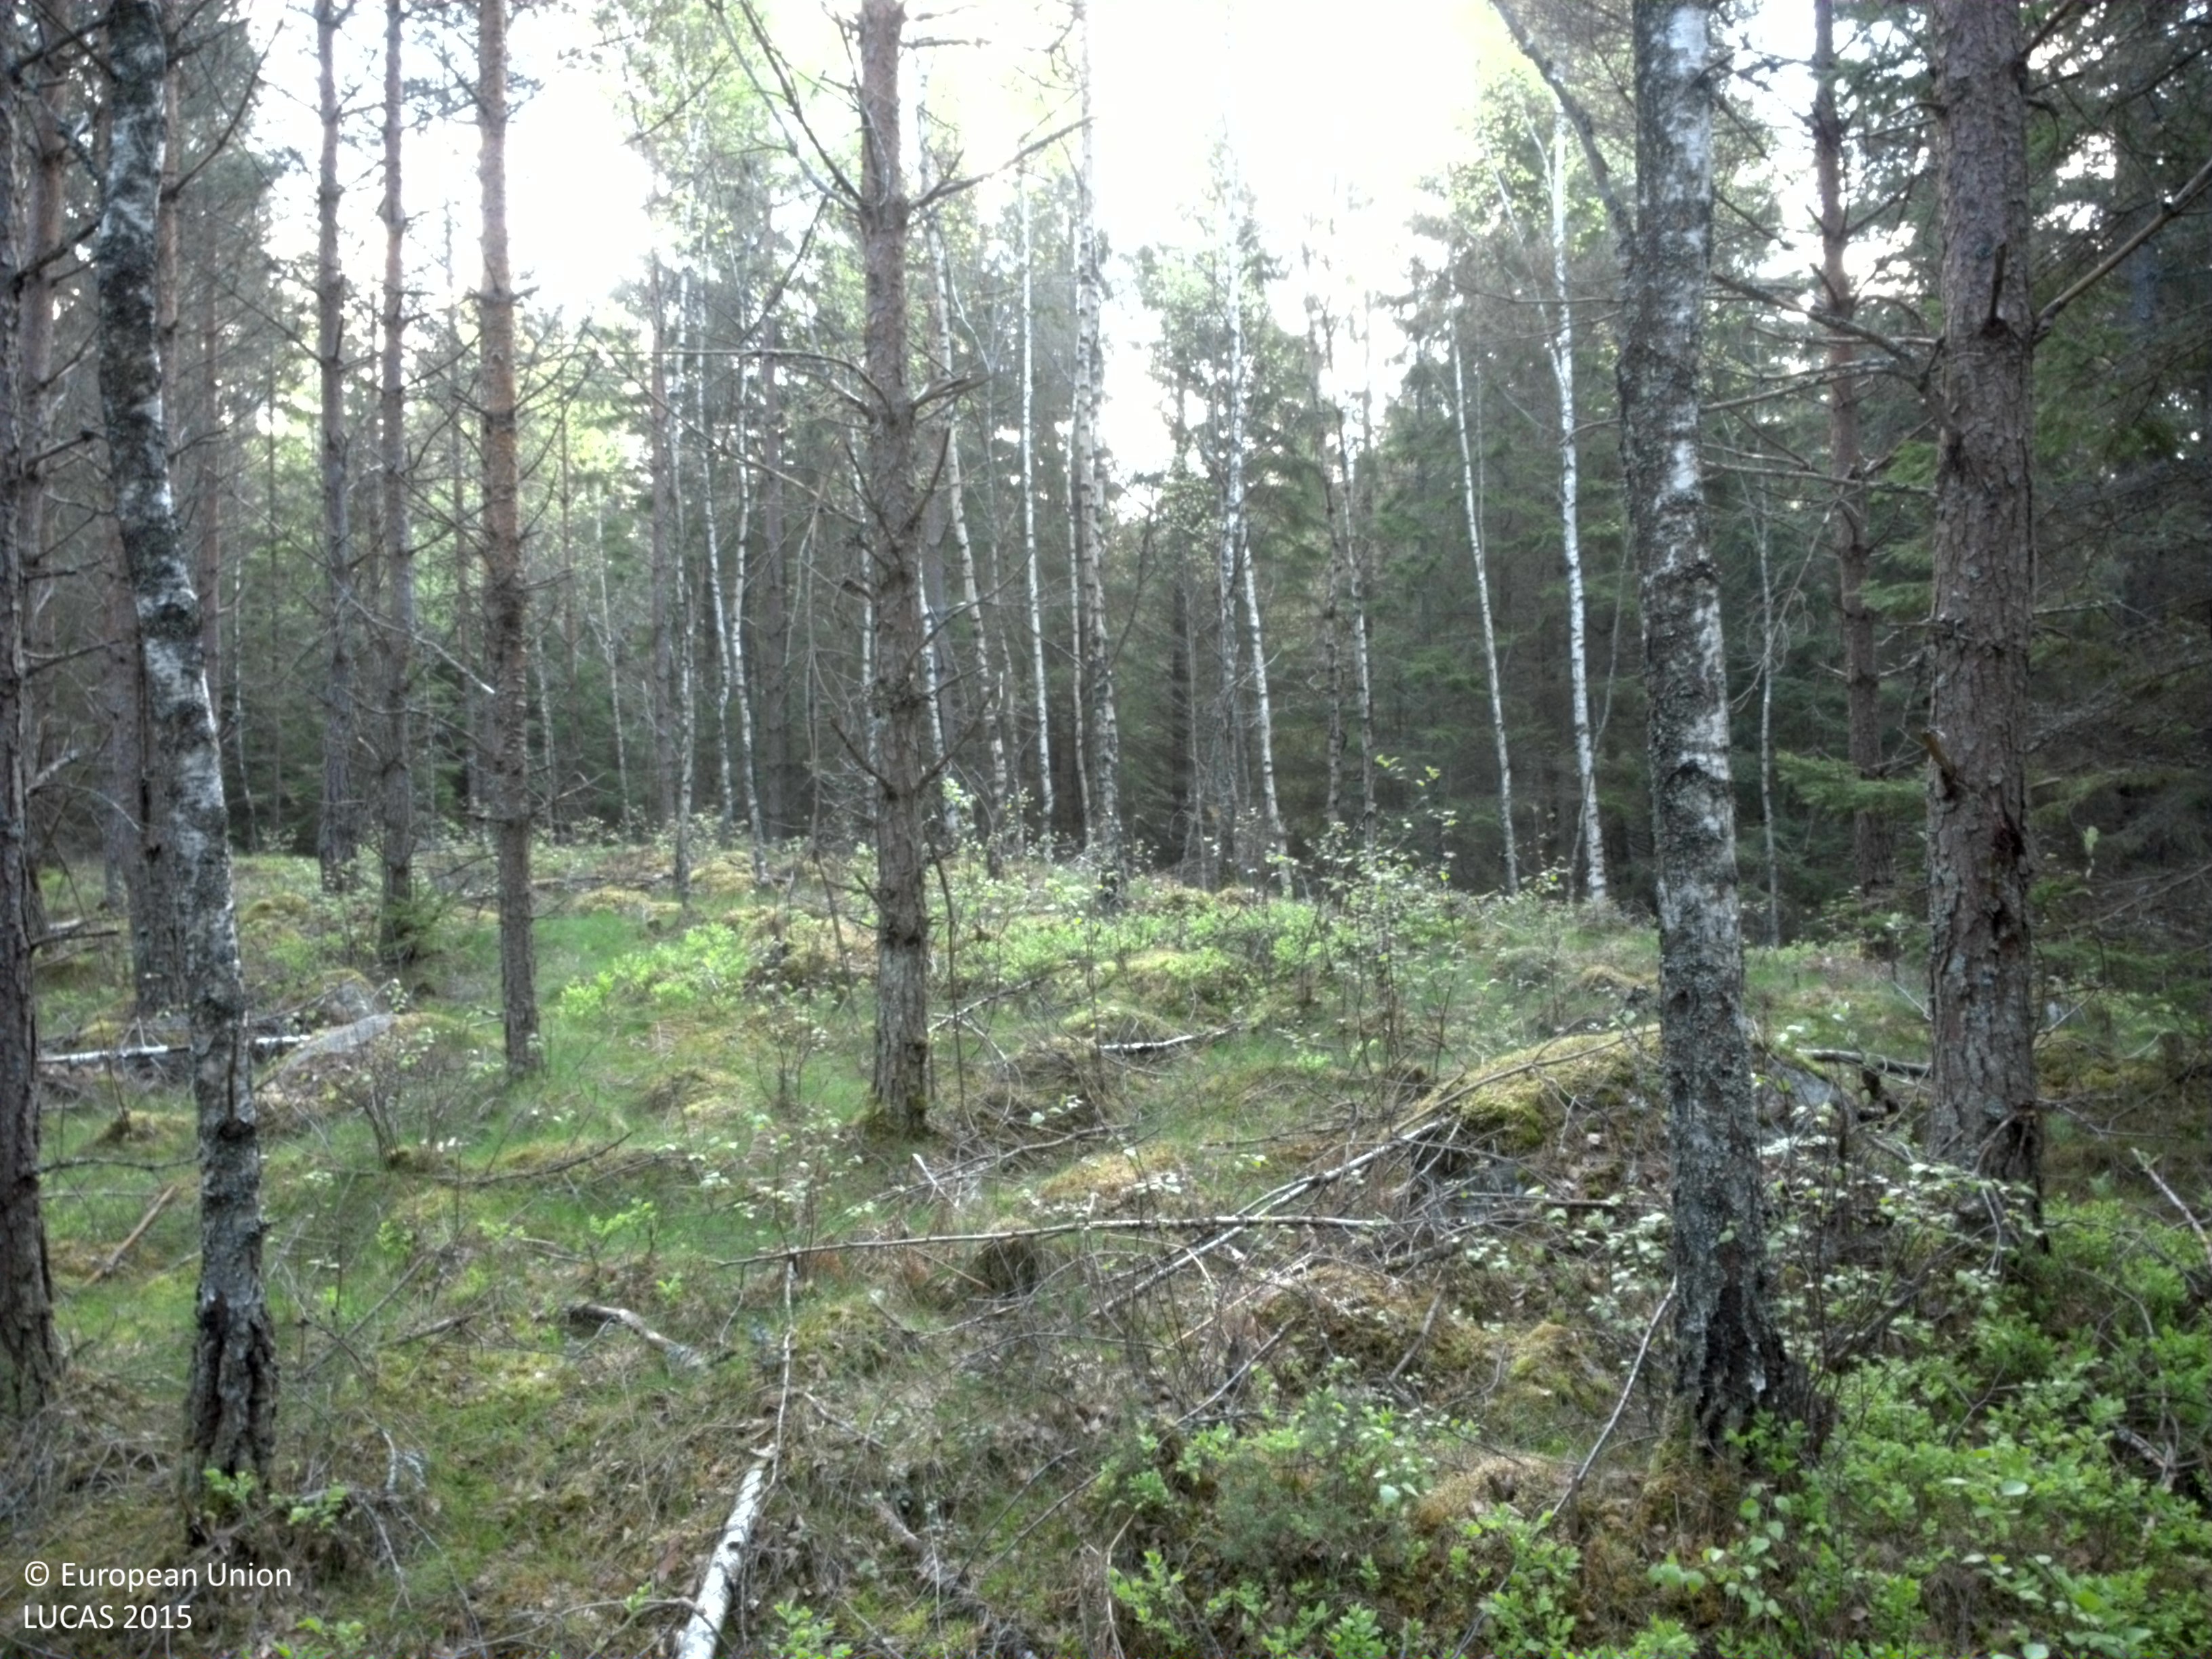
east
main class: Woodland
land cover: Pine dominated coniferous woodland
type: boreal forest
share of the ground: 50 - 75 %
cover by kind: coniferous forest trees 70 %, lichens and mosses 25 %, broadleaved forest trees 5 %
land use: Forestry
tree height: > 5 m
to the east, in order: Pine dominated coniferous woodland; Pine dominated mixed woodland; Spruce dominated coniferous woodland; Ditches and canals; Spruce dominated coniferous woodland; Ditches and canals; Spruce dominated coniferous woodland; Paved roads, cycling and walking lanes; Spruce dominated coniferous woodland
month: May
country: SE
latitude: 56.5567
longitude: 14.5692
